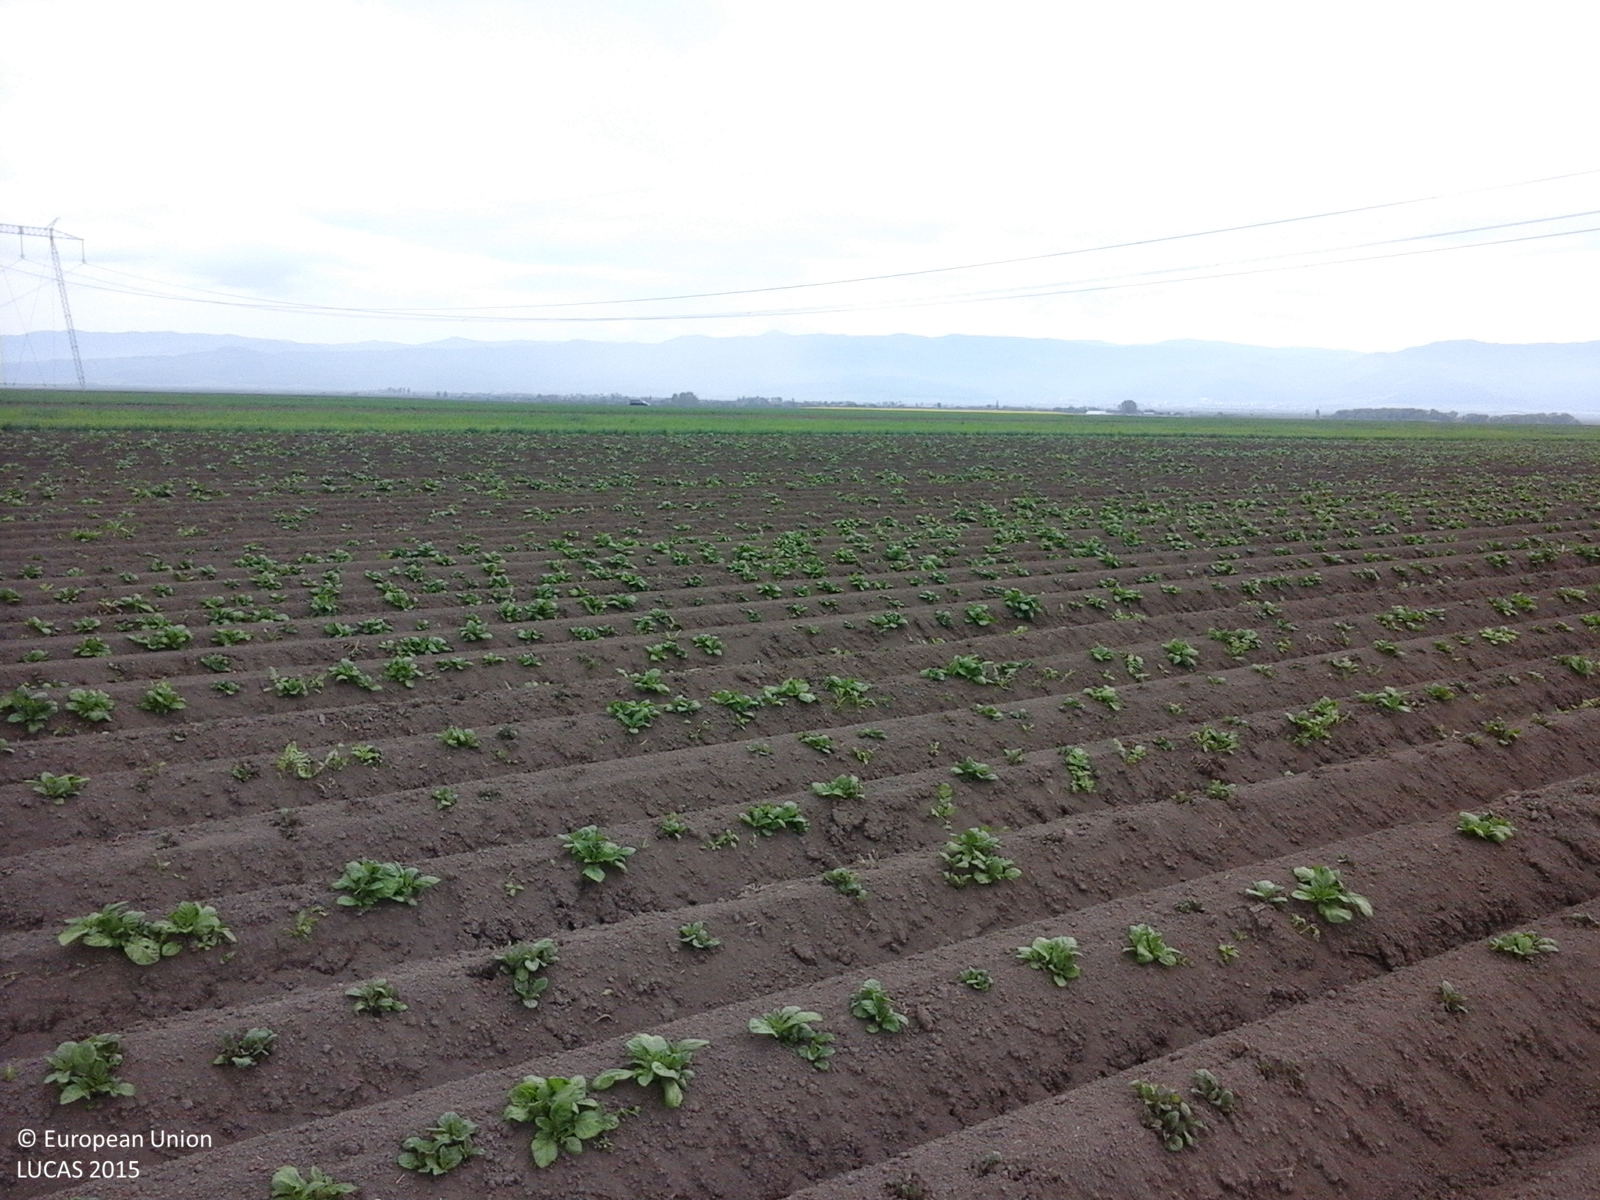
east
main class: Cropland
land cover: Potatoes
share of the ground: < 10 %
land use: Agriculture (excluding fallow land and kitchen gardens)
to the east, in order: Potatoes; Common wheat; Sugar beet; Common wheat; Electric lines; Common wheat
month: May
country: RO
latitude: 45.8845
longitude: 26.0306
